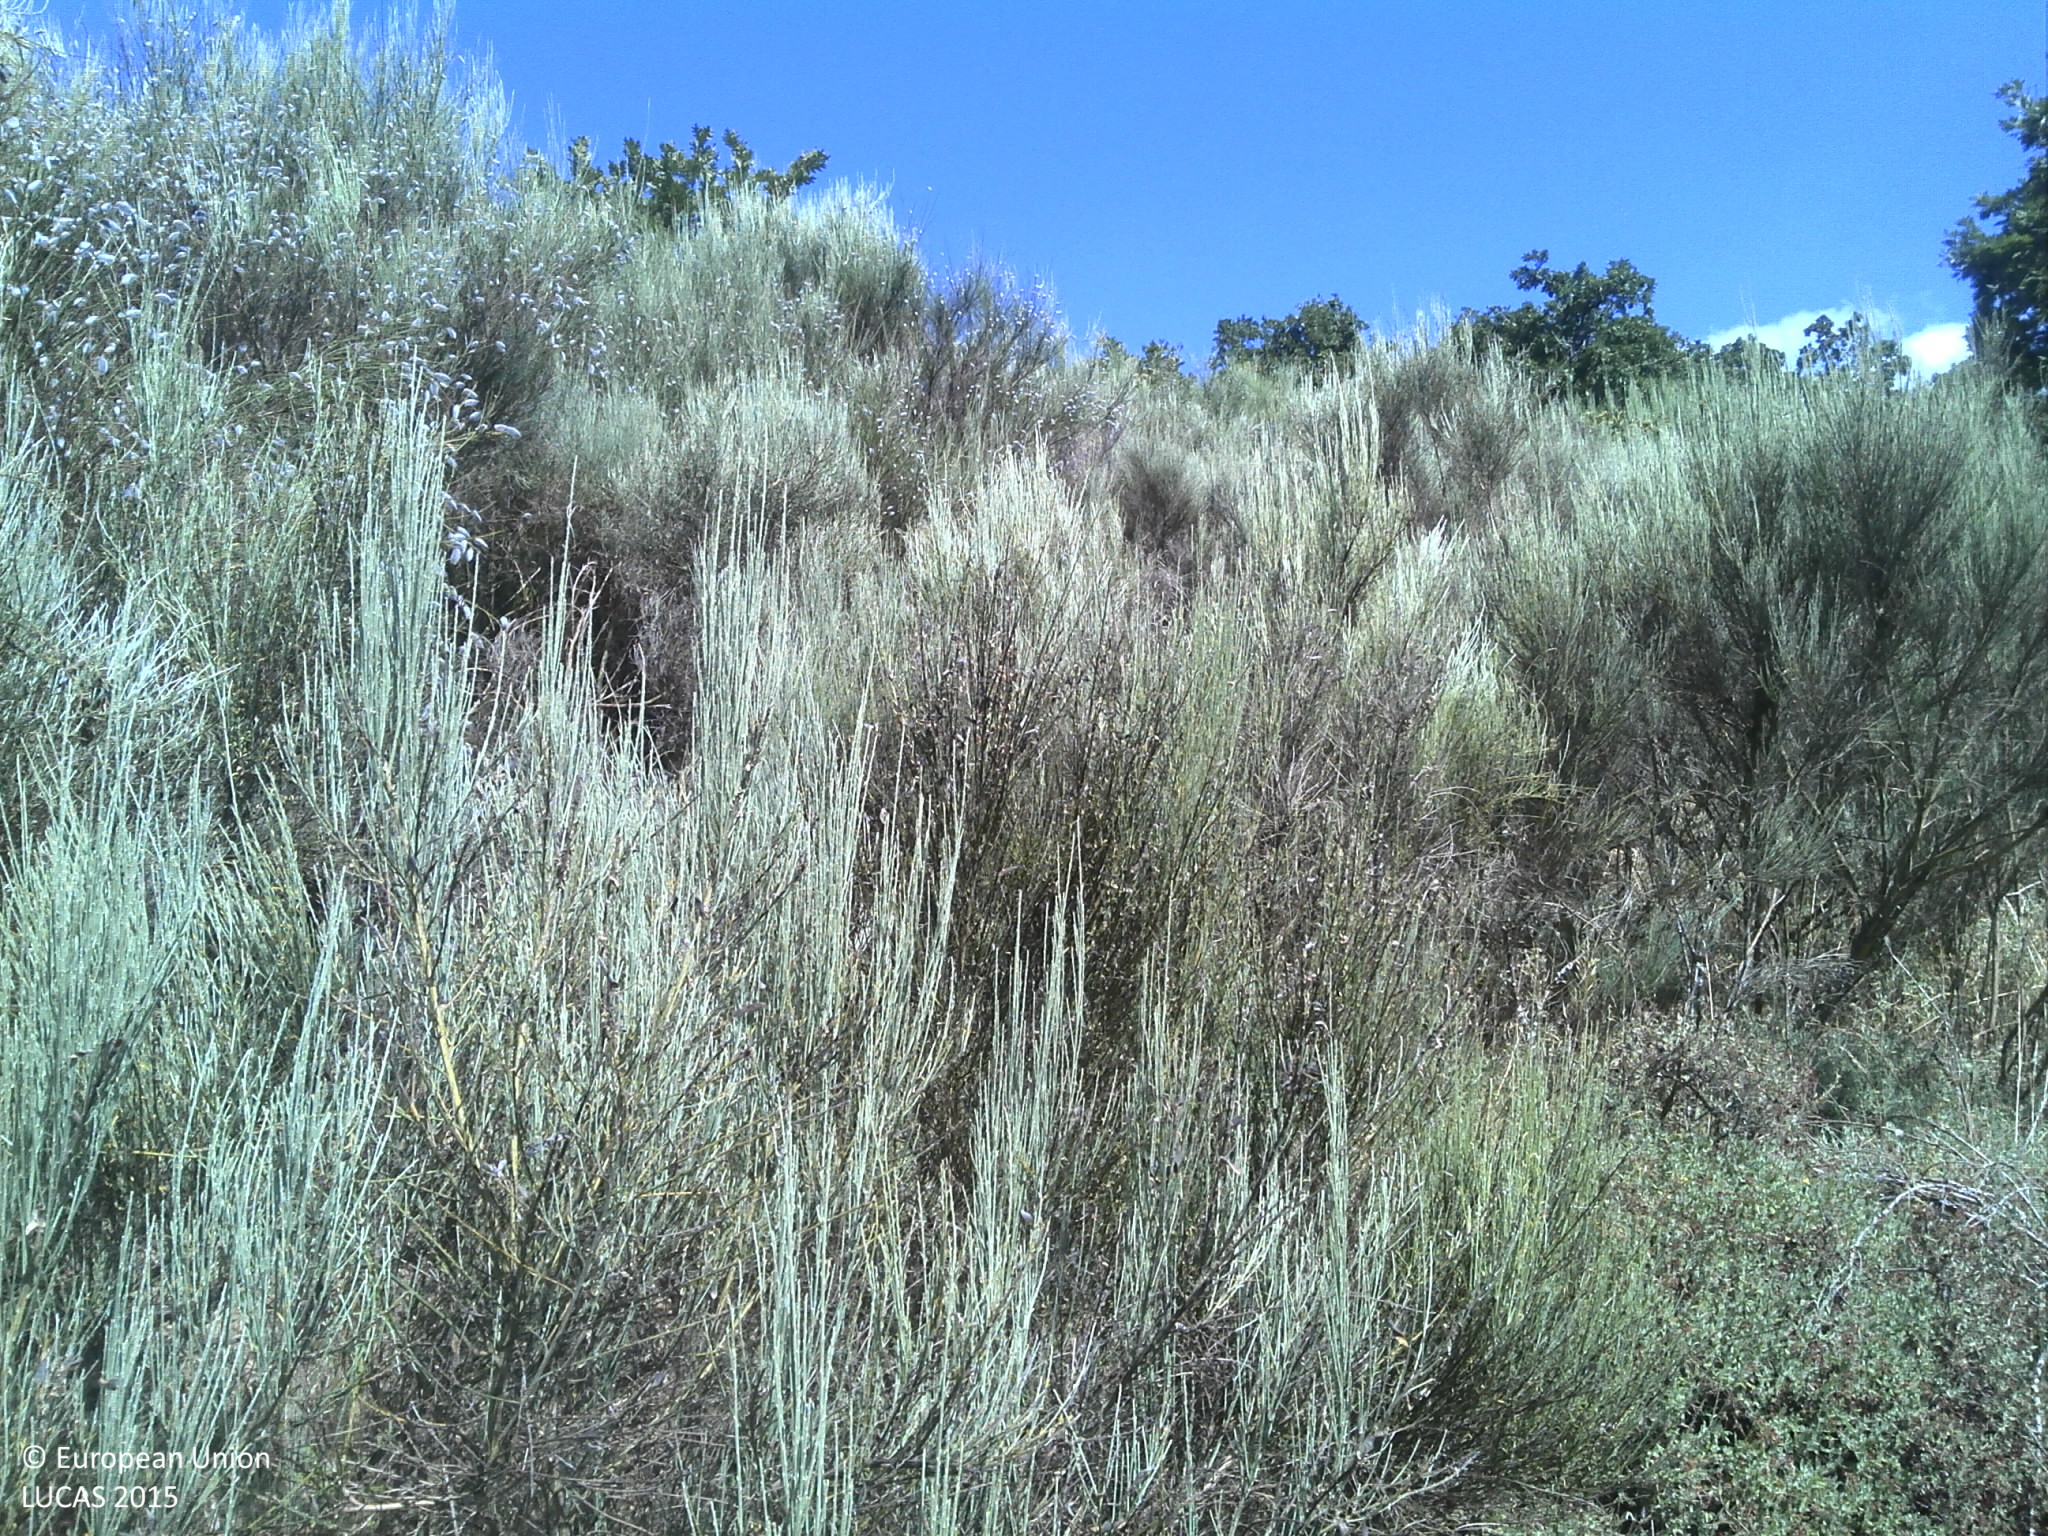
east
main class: Shrubland
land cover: Shrubland without tree cover
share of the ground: 25 - 50 %
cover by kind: shrubs 45 %, unconsolidated bare surface 30 %, herbaceous plants 15 %
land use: Semi-natural and natural areas not in use
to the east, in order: Shrubland without tree cover; Shrubland with sparse tree cover
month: August
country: PT
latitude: 40.5088
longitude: -7.4943
